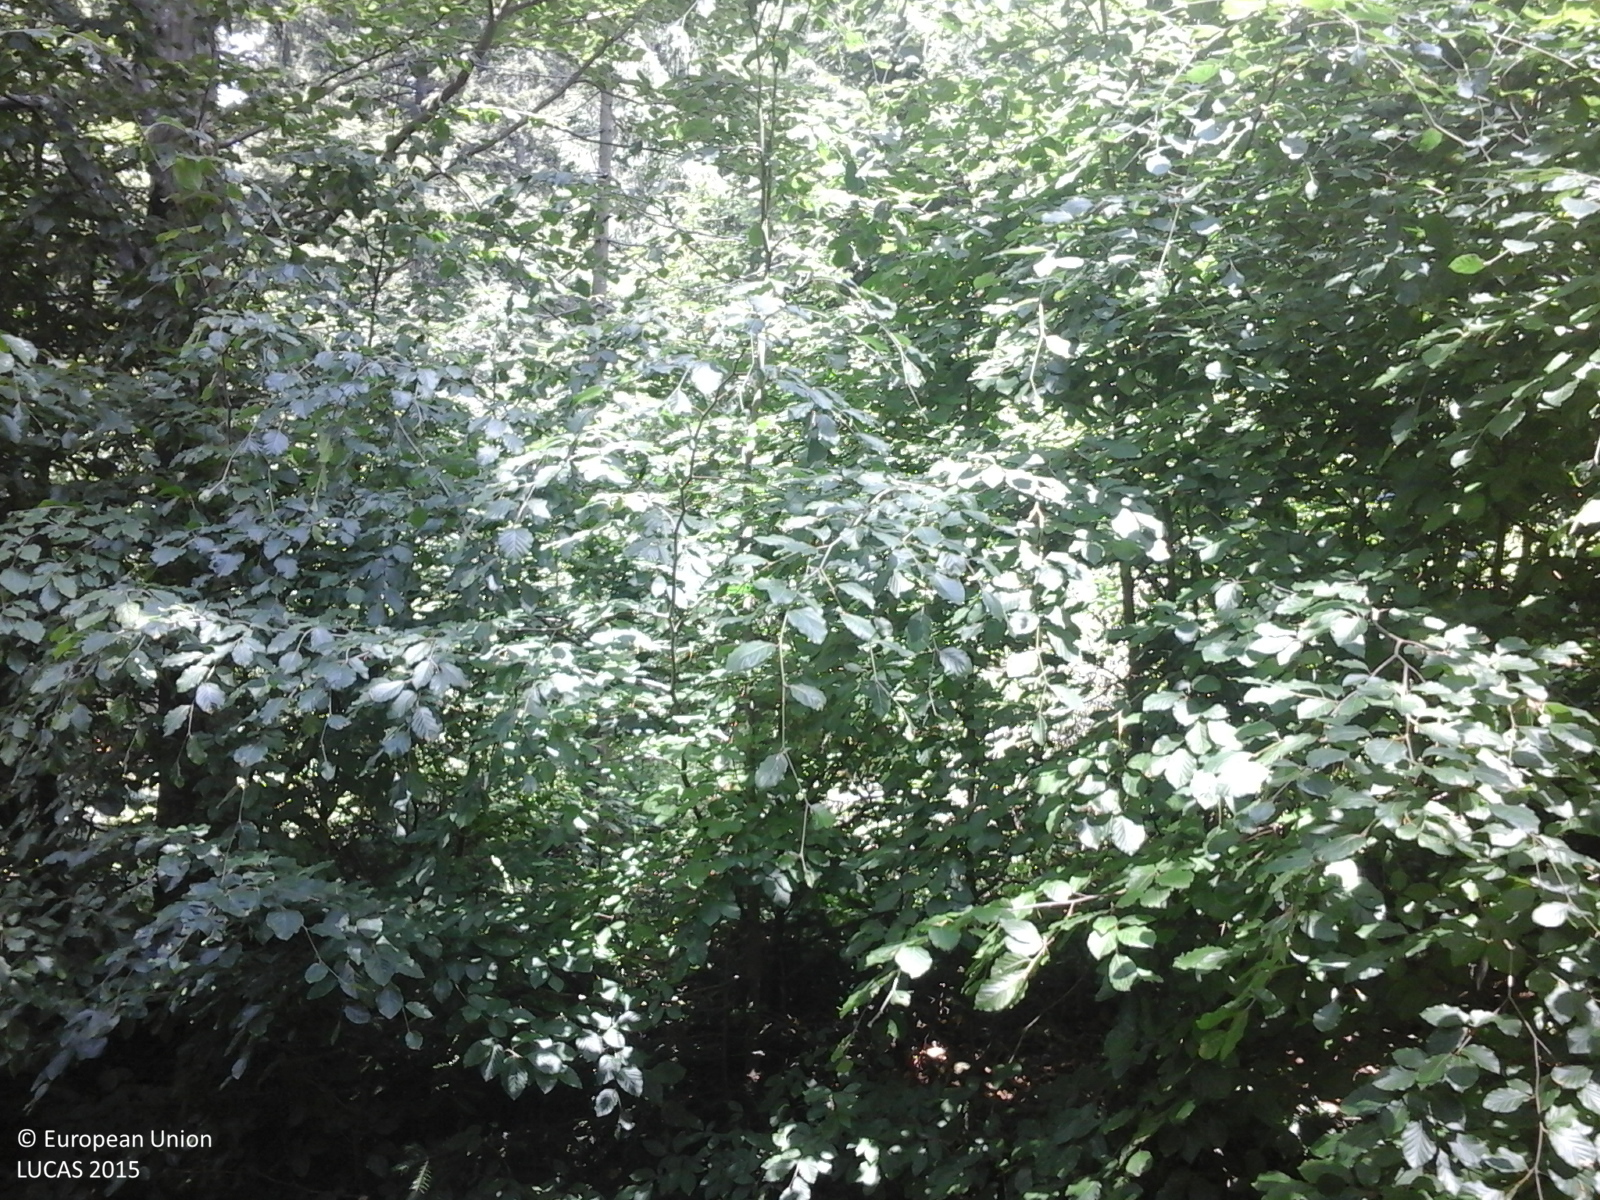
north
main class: Woodland
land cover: Other mixed woodland
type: beech forest
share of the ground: > 75 %
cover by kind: broadleaved forest trees 75 %, coniferous forest trees 25 %
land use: Forestry
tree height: > 5 m
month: June
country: RO
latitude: 47.6906
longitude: 25.7246
